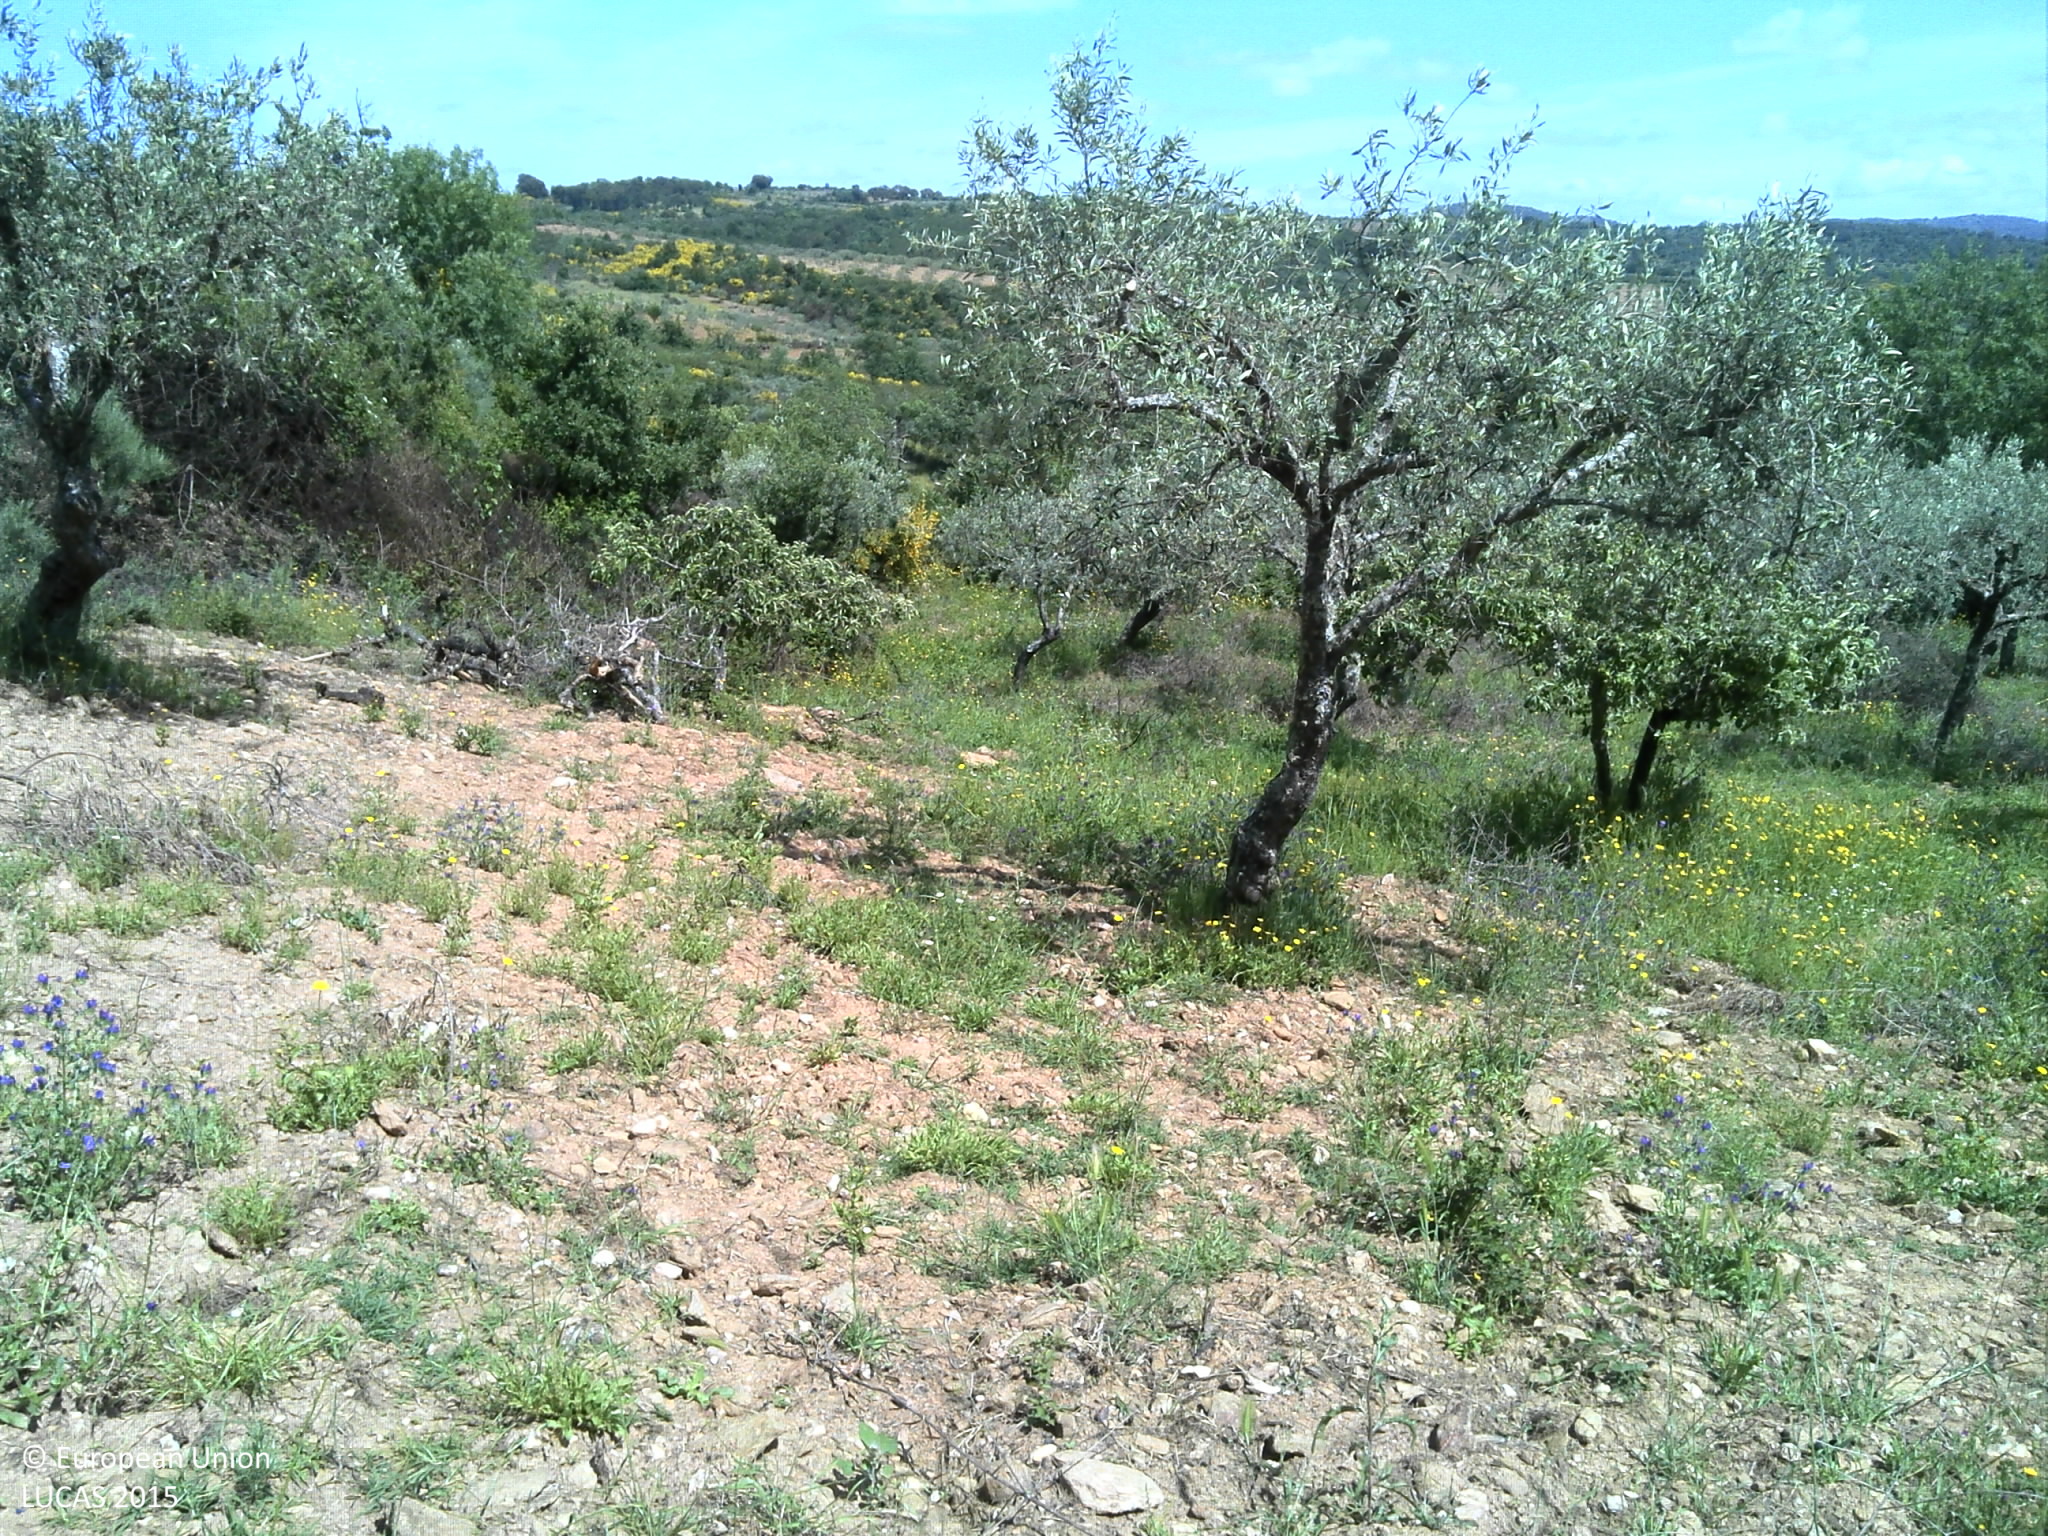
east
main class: Cropland
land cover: Olive groves
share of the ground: 25 - 50 %
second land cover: Spontaneously vegetated surfaces
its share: 10 - 25 %
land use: Agriculture (excluding fallow land and kitchen gardens)
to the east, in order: Olive groves; Spontaneously vegetated surfaces; Olive groves; Shrubland with sparse tree cover; Olive groves; Dry stone walls; Shrubland with sparse tree cover; Rivers and streams; Grassland with sparse tree/shrub cover; Shrubland without tree cover
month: May
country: PT
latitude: 41.5800
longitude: -7.0652
